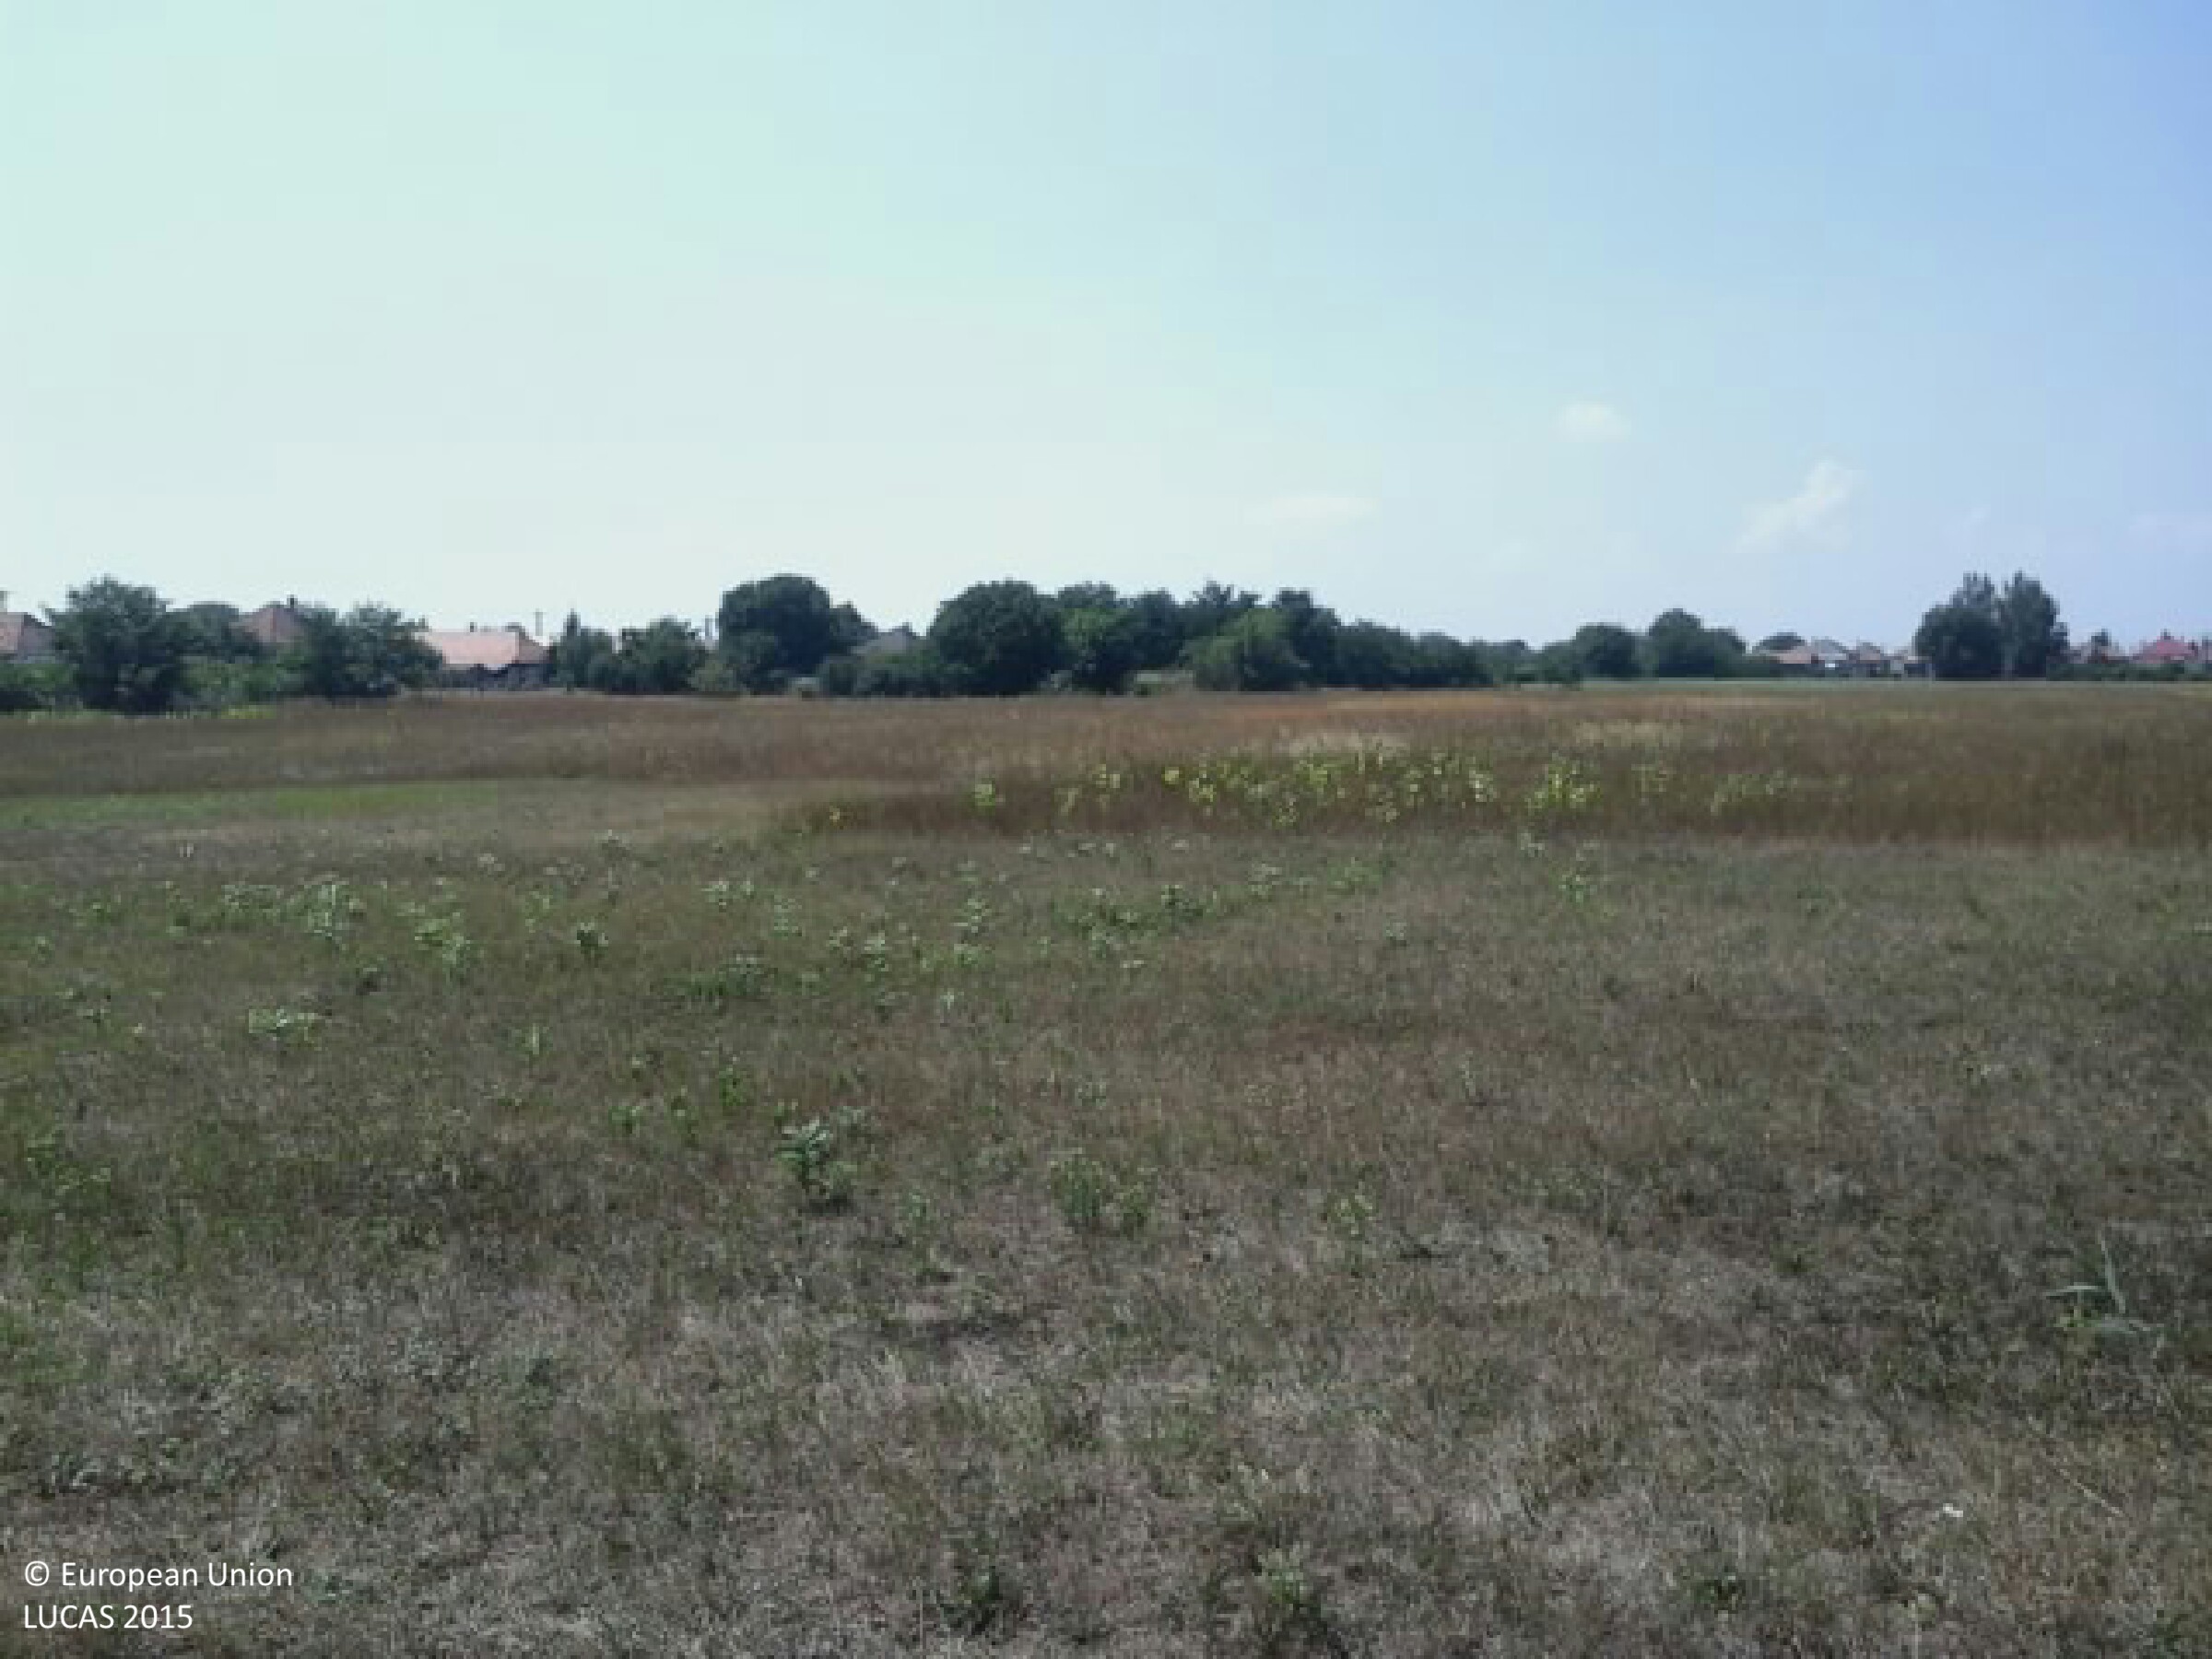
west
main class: Grassland
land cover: Grassland without tree/shrub cover
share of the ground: > 75 %
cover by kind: herbaceous plants 100 %
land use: Agriculture (excluding fallow land and kitchen gardens)
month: August
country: HU
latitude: 47.2448
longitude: 19.3598
